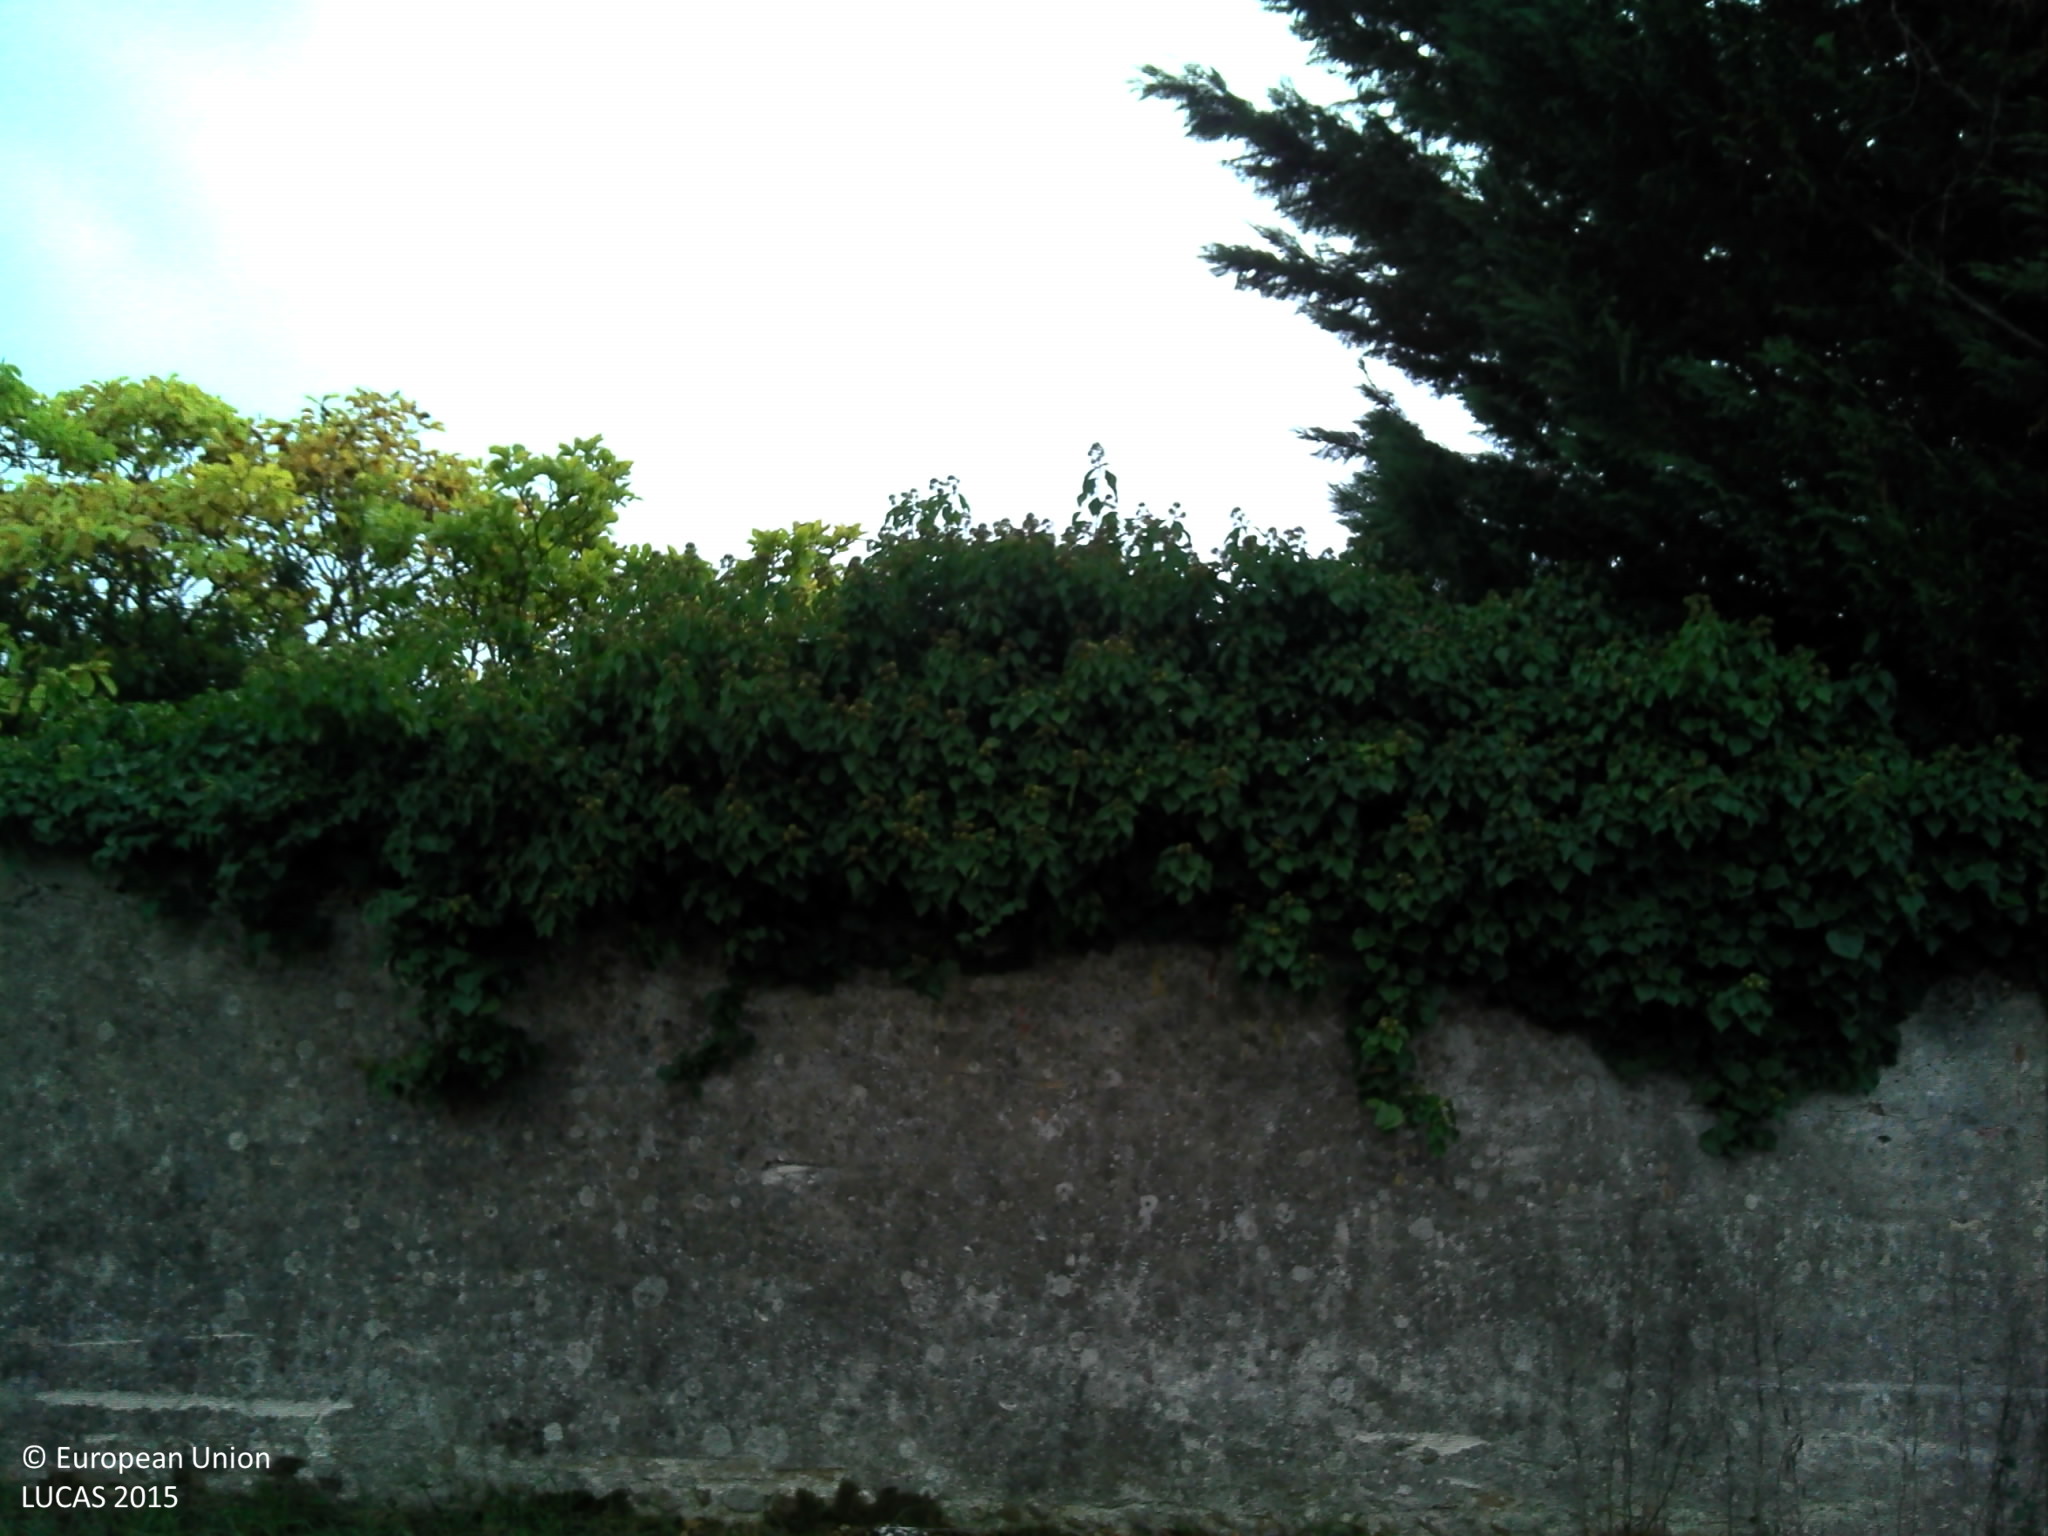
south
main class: Grassland
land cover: Grassland without tree/shrub cover
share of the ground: > 75 %
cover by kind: herbaceous plants 100 %
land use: Agriculture (excluding fallow land and kitchen gardens)
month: October
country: FR
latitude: 46.1710
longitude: 4.8087
